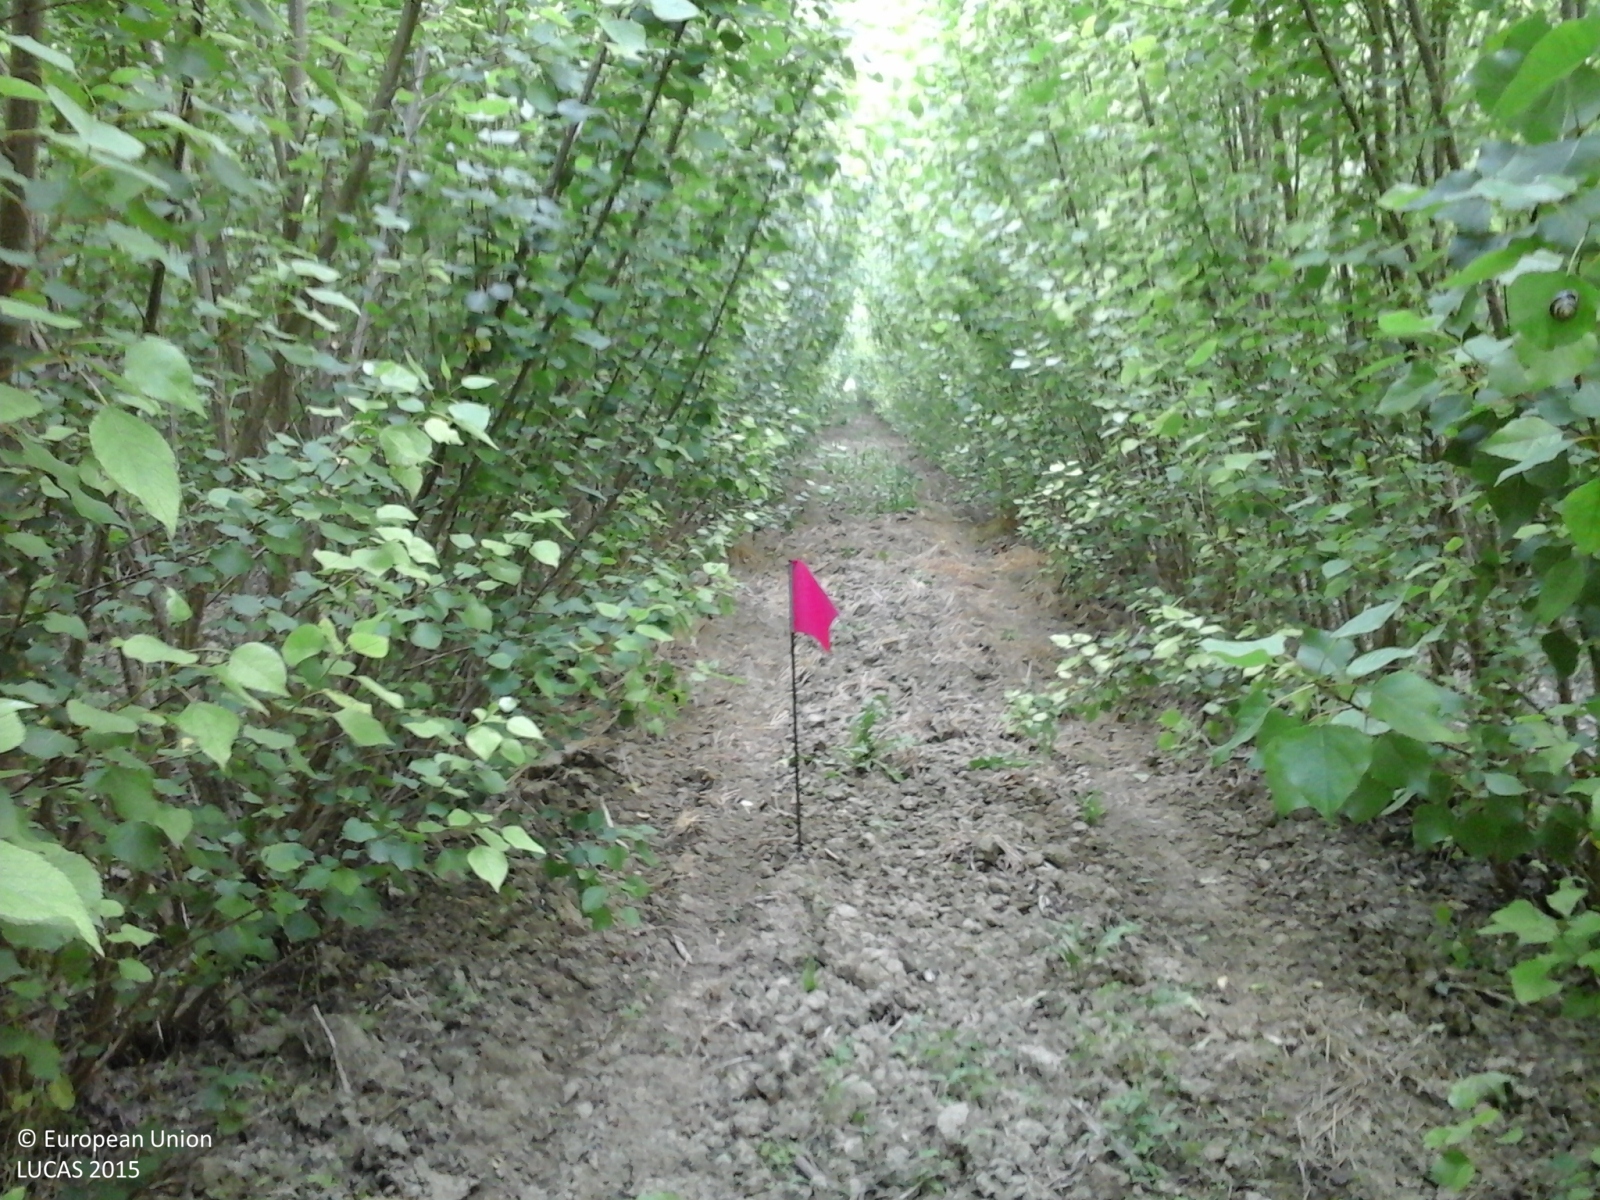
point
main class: Woodland
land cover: Broadleaved woodland
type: non-riverine alder, birch or aspen forest
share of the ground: > 75 %
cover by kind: broadleaved forest trees 100 %
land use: Forestry
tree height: < 5 m
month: June
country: IT
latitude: 44.8021
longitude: 11.9053
